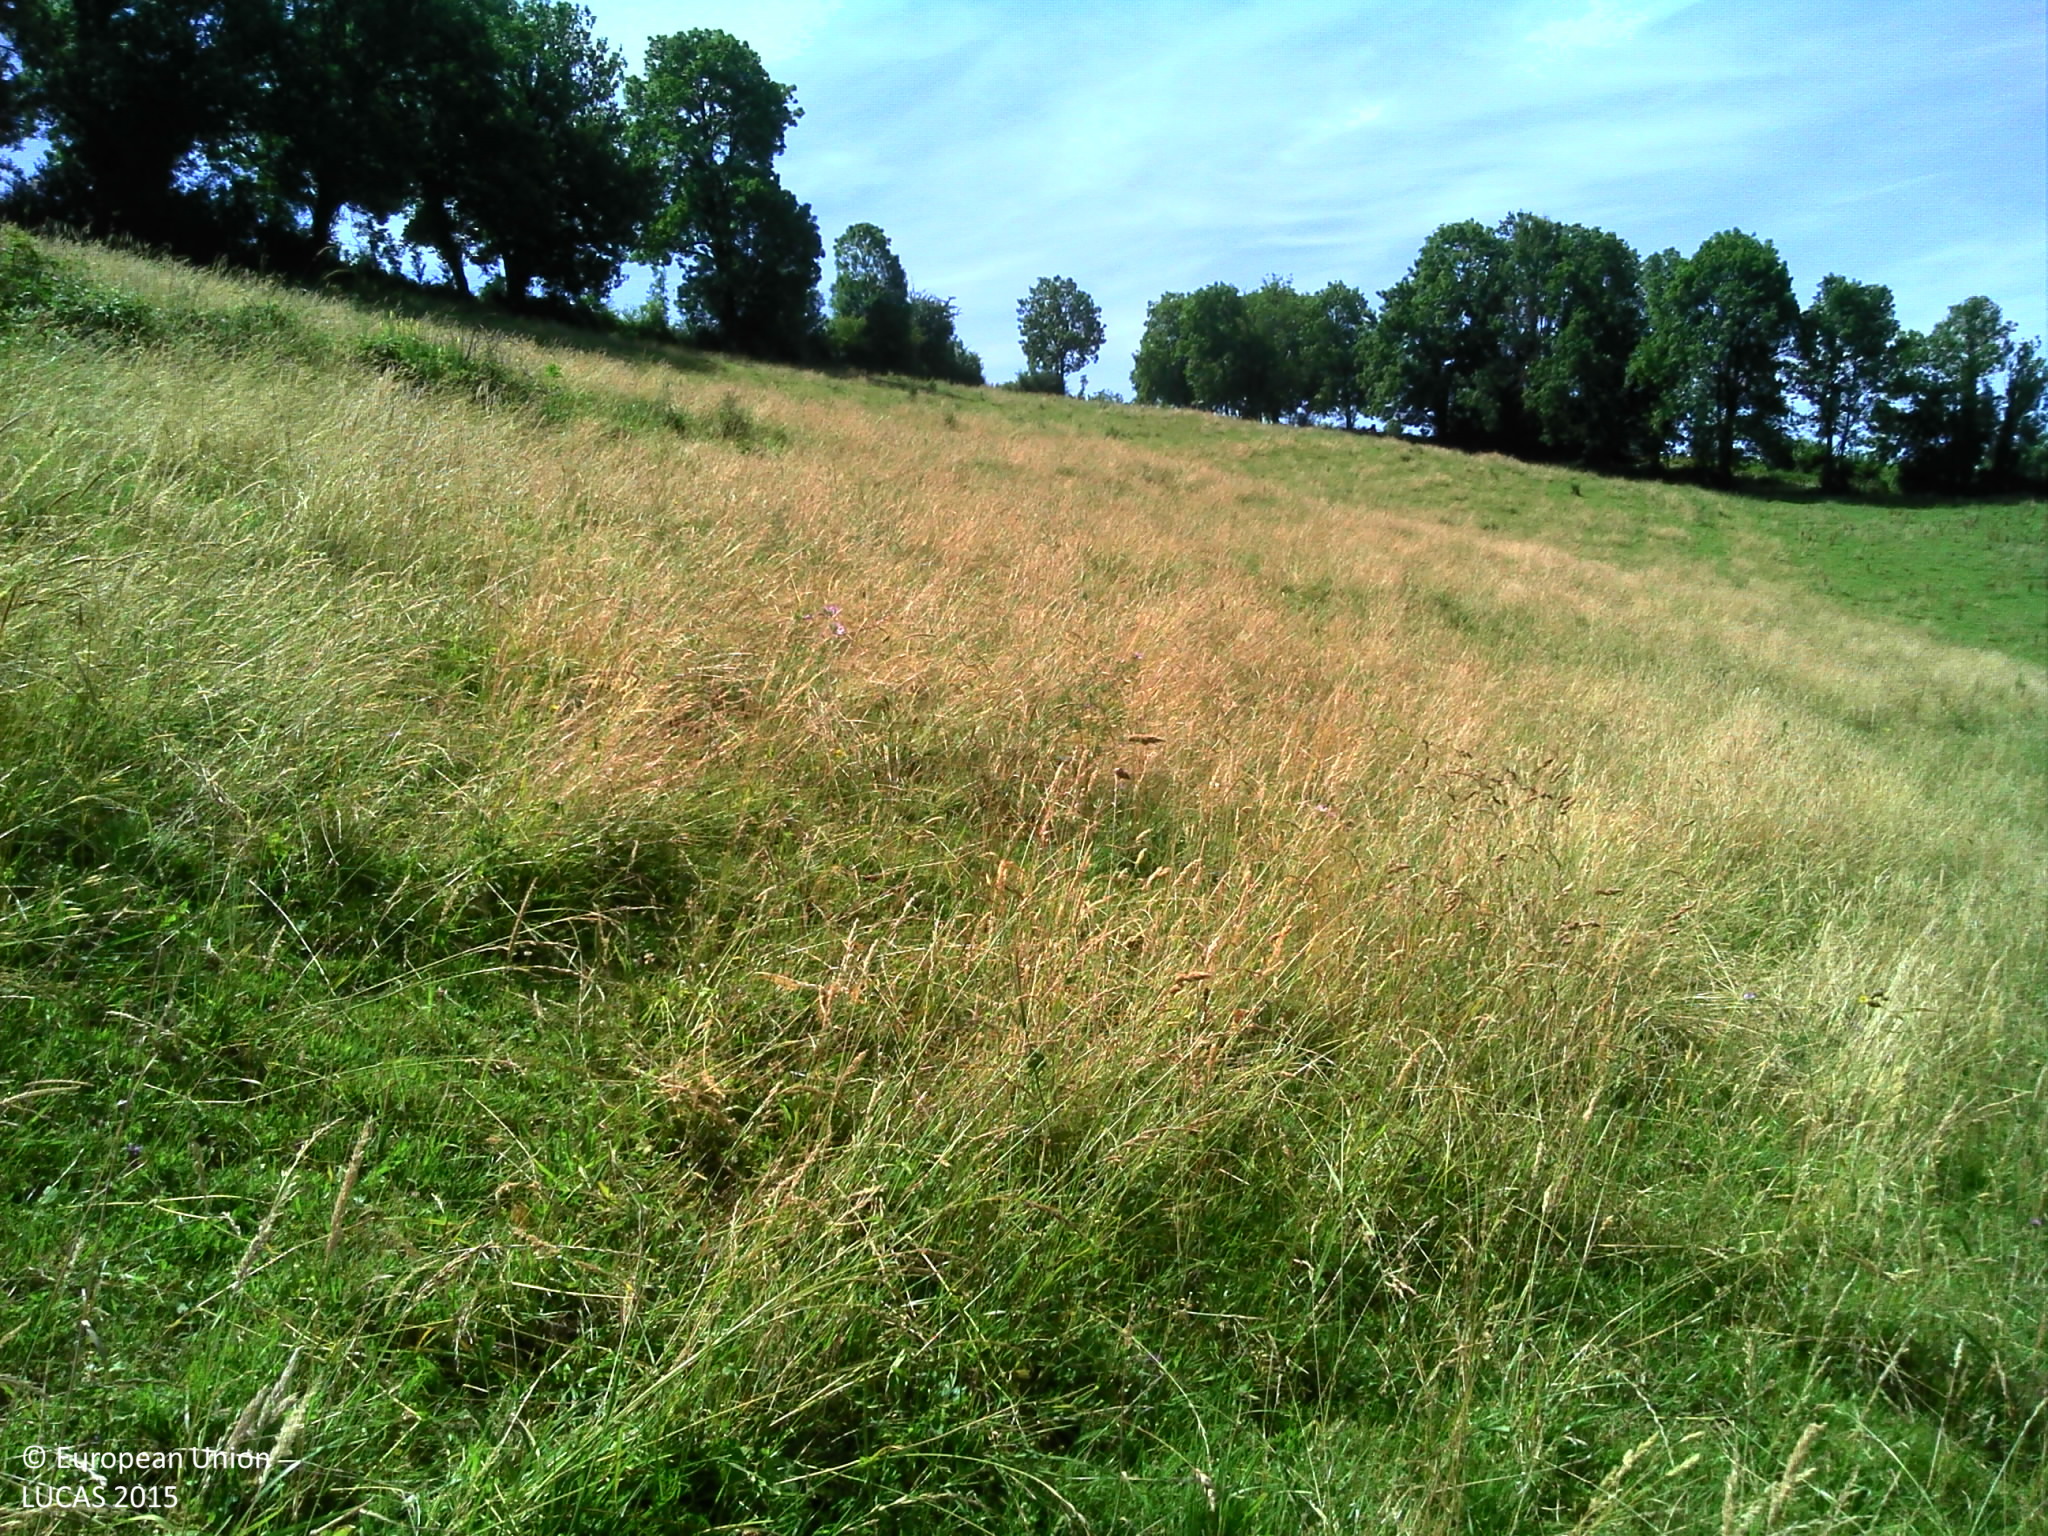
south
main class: Grassland
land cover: Grassland without tree/shrub cover
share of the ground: > 75 %
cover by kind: herbaceous plants 100 %
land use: Agriculture (excluding fallow land and kitchen gardens)
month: June
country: FR
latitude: 46.4554
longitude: 5.5110
